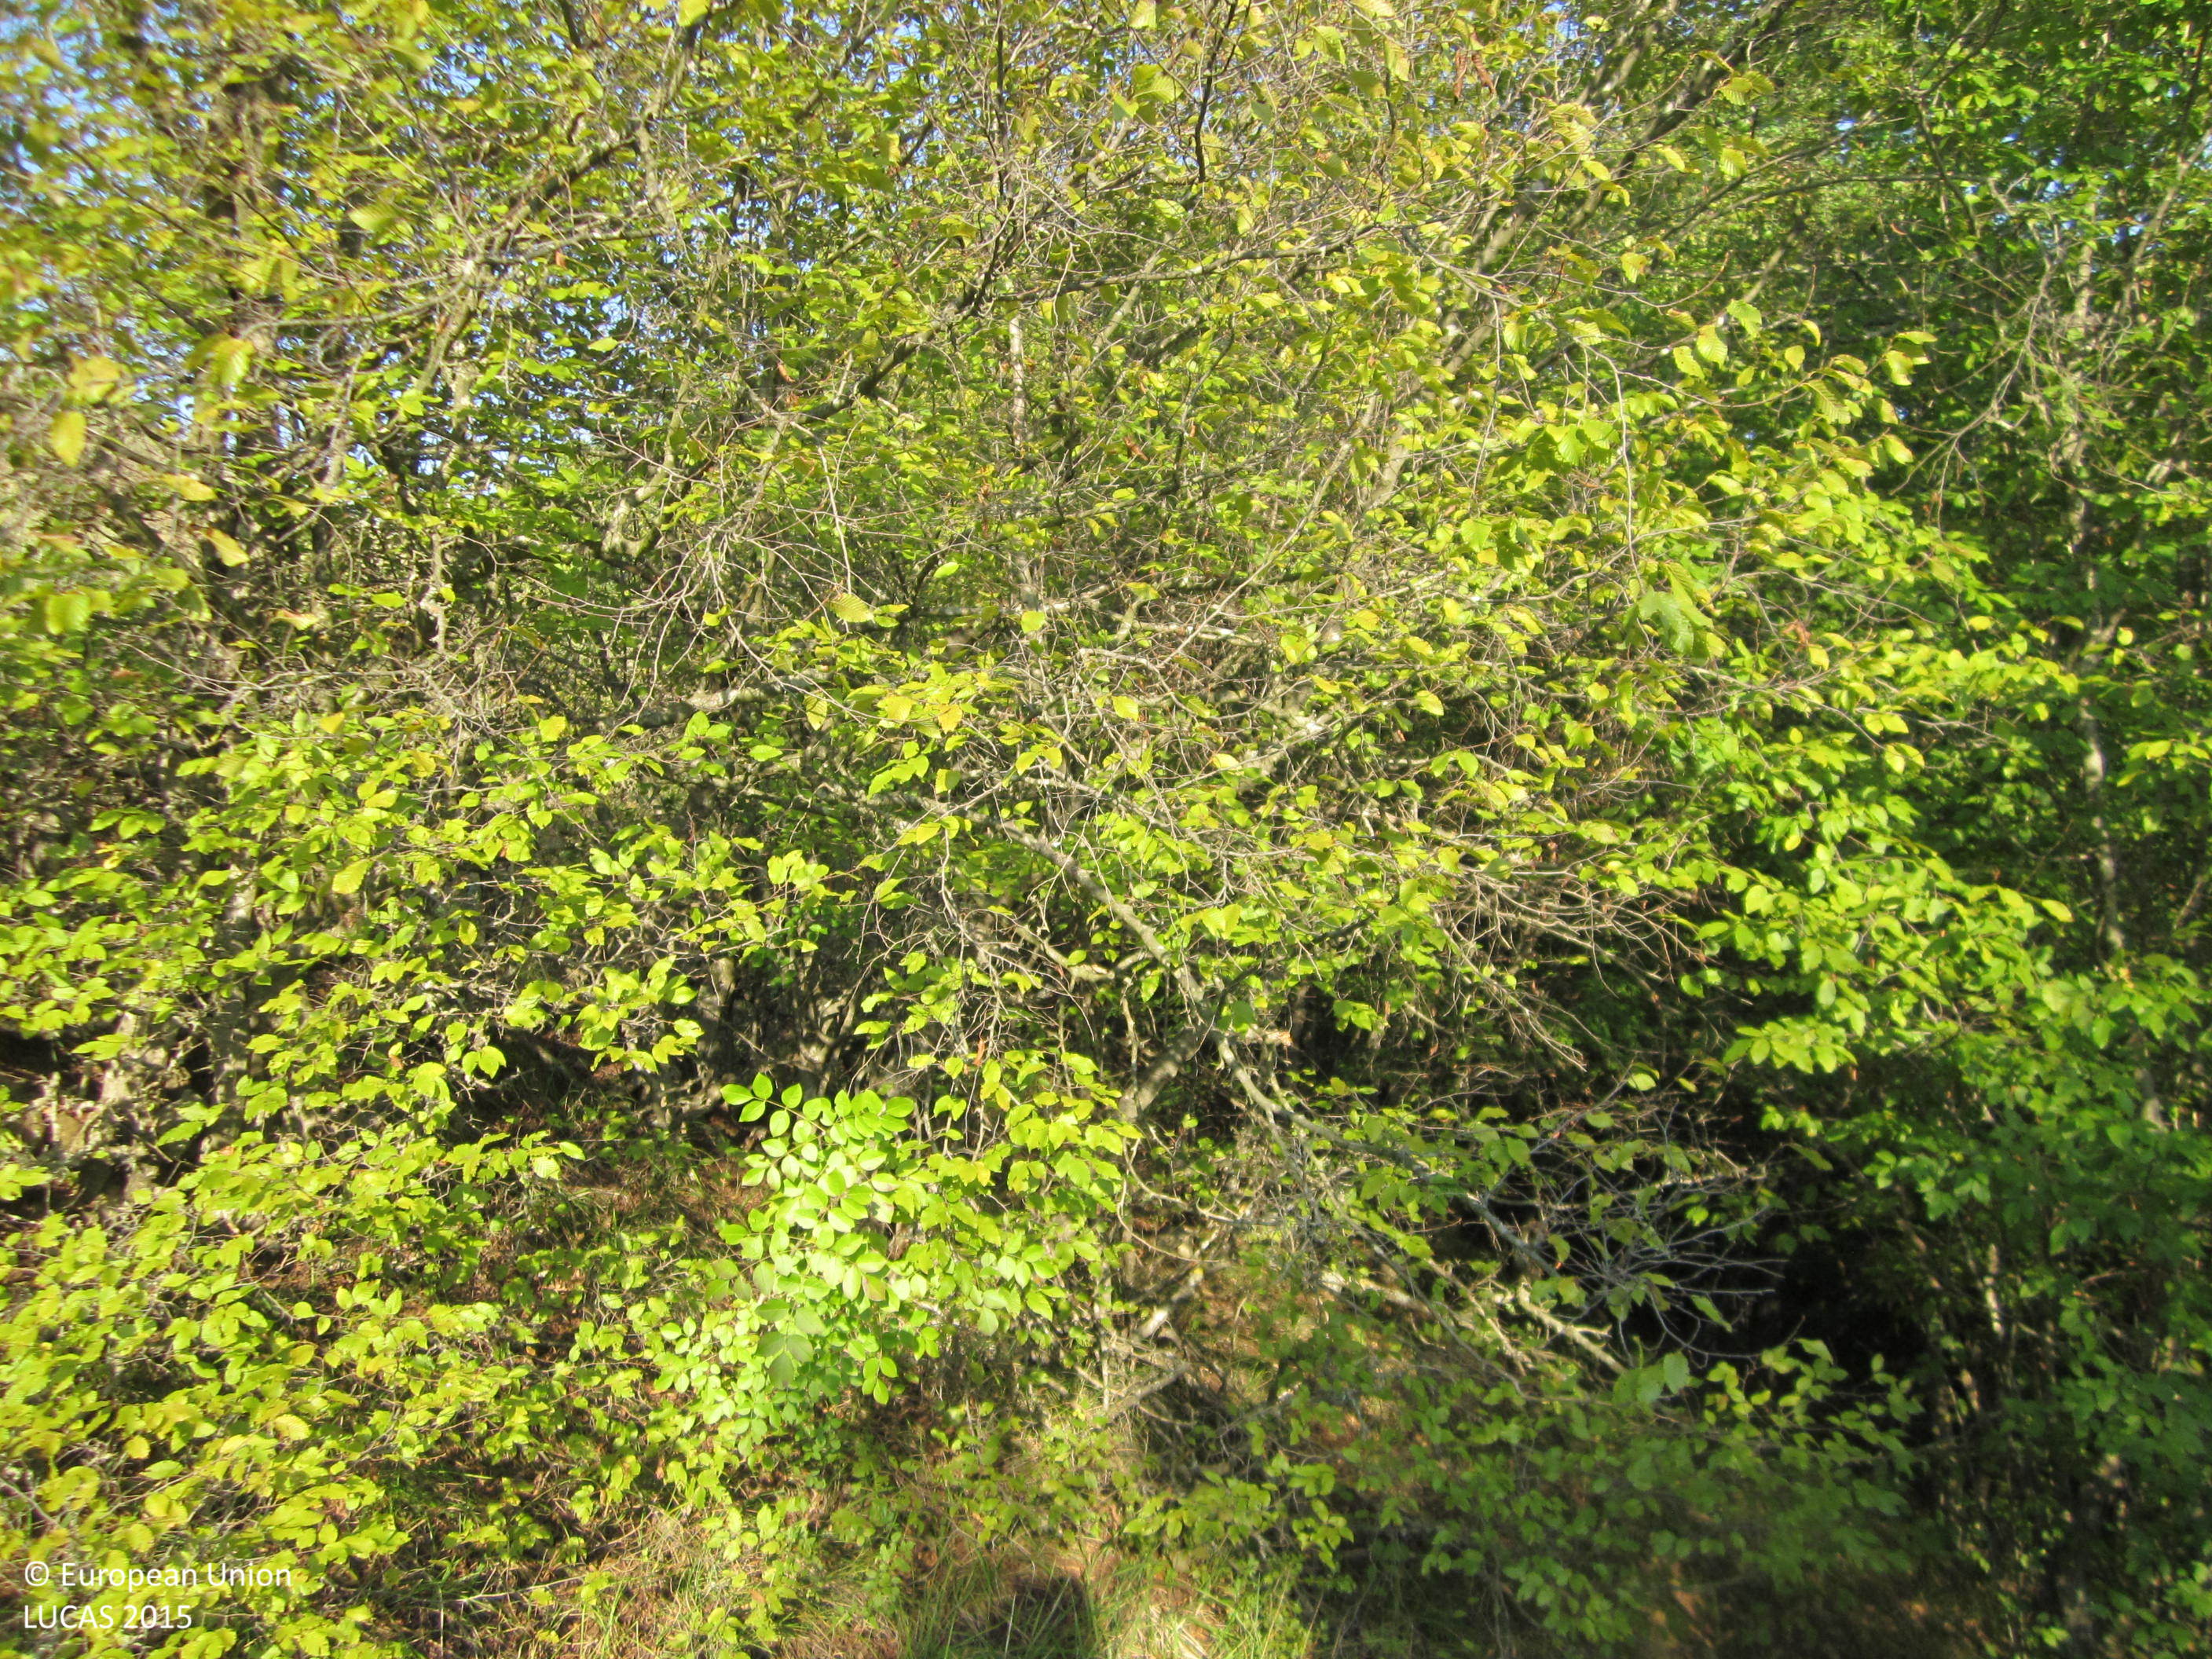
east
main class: Woodland
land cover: Broadleaved woodland
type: mesophytic deciduous forest
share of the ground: > 75 %
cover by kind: broadleaved forest trees 100 %
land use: Forestry
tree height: > 5 m
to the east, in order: Broadleaved woodland
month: September
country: BG
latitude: 42.9011
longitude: 27.1999
